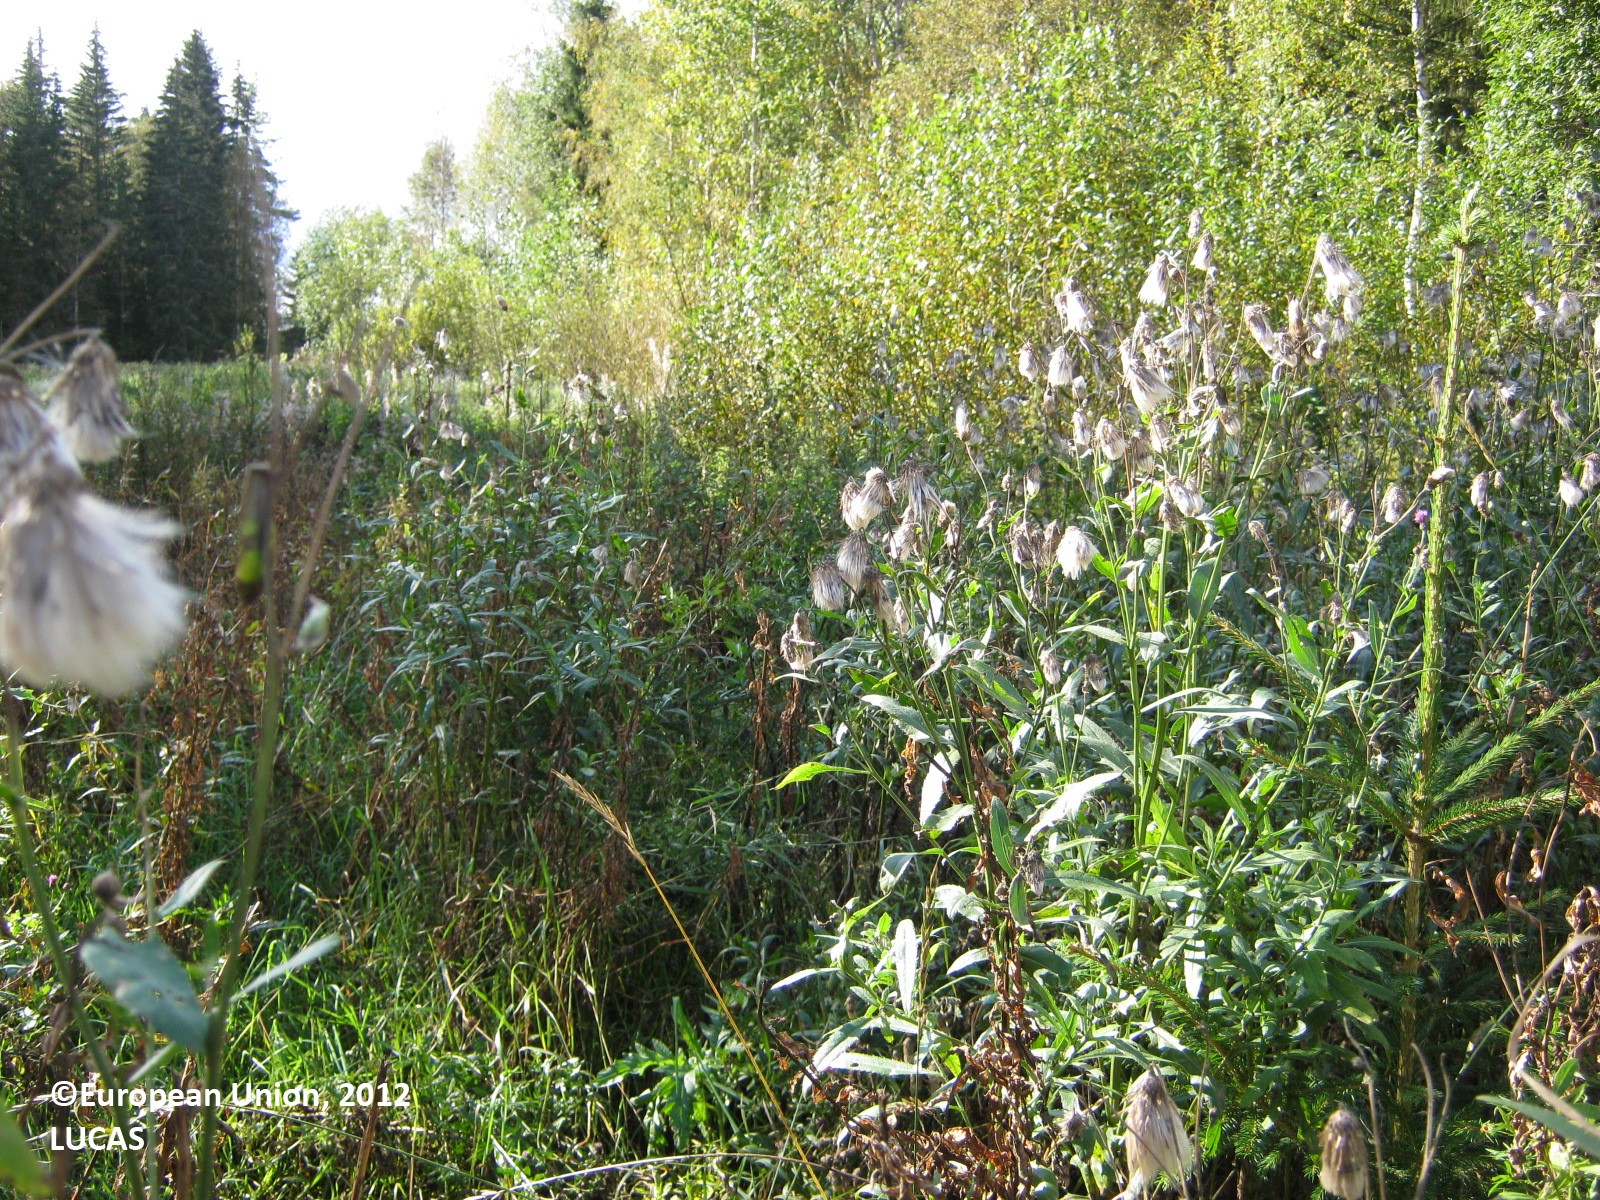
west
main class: Shrubland
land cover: Shrubland with sparse tree cover
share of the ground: > 75 %
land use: Semi-natural and natural areas not in use
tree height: < 5 m
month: September
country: FI
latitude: 60.8932
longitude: 27.7544
